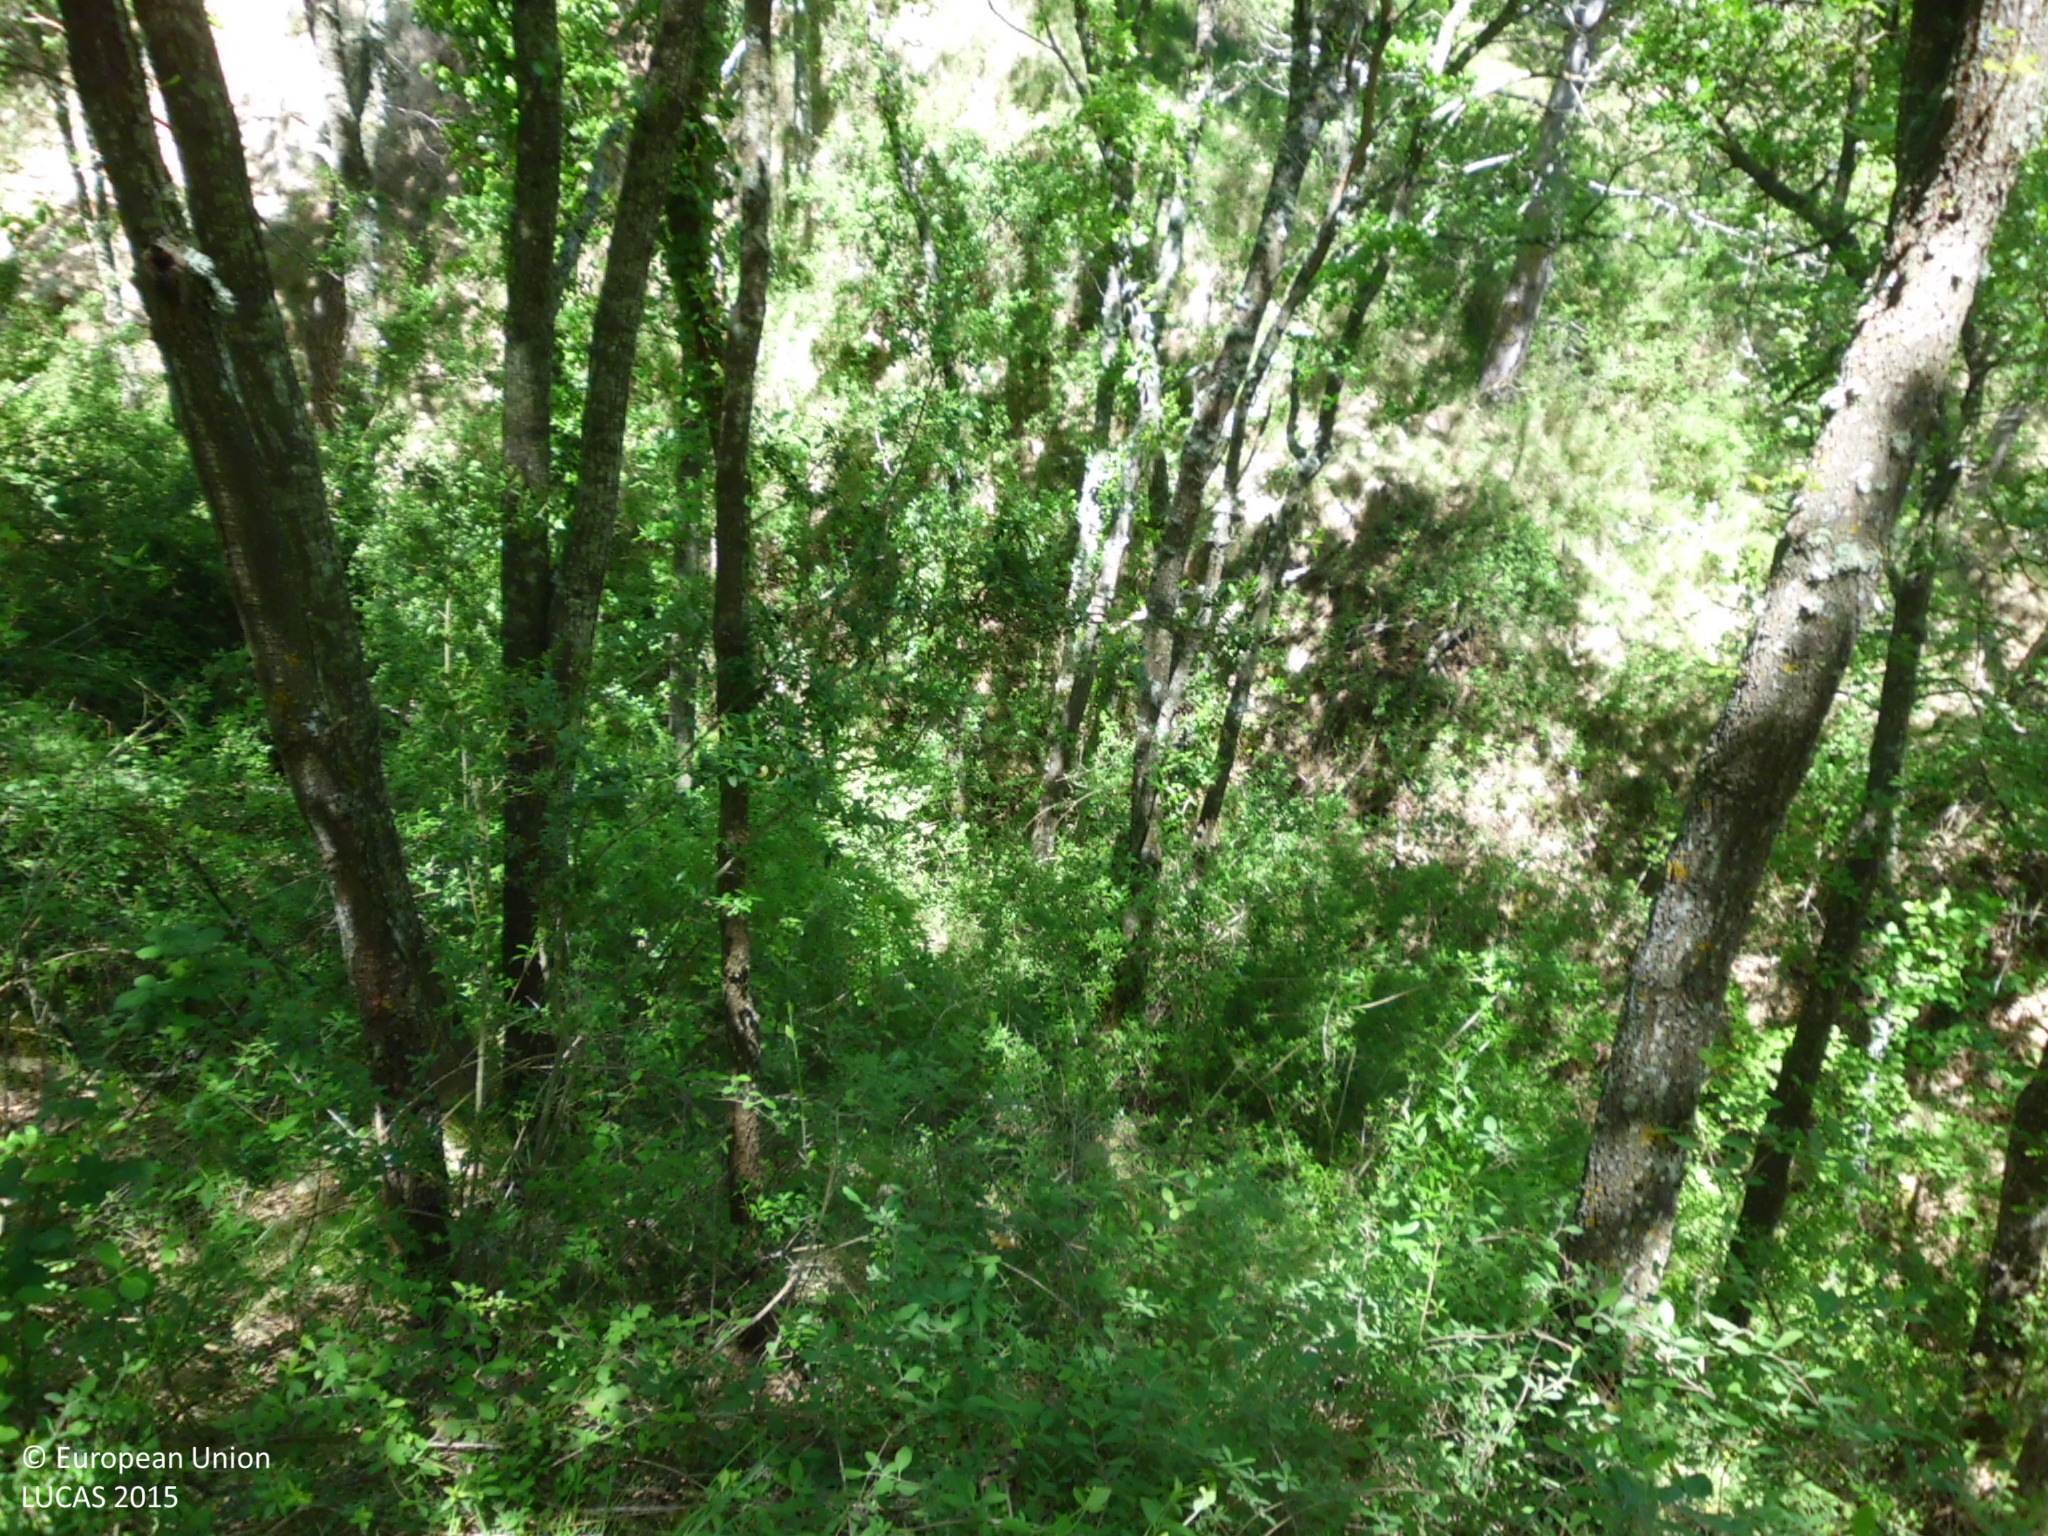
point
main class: Woodland
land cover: Pine dominated mixed woodland
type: coniferous forest of the mediterranean region
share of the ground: 50 - 75 %
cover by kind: coniferous forest trees 45 %, broadleaved forest trees 25 %, shrubs 20 %, herbaceous plants 10 %
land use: Semi-natural and natural areas not in use
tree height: > 5 m
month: May
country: ES
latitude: 42.7203
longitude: -3.4569
